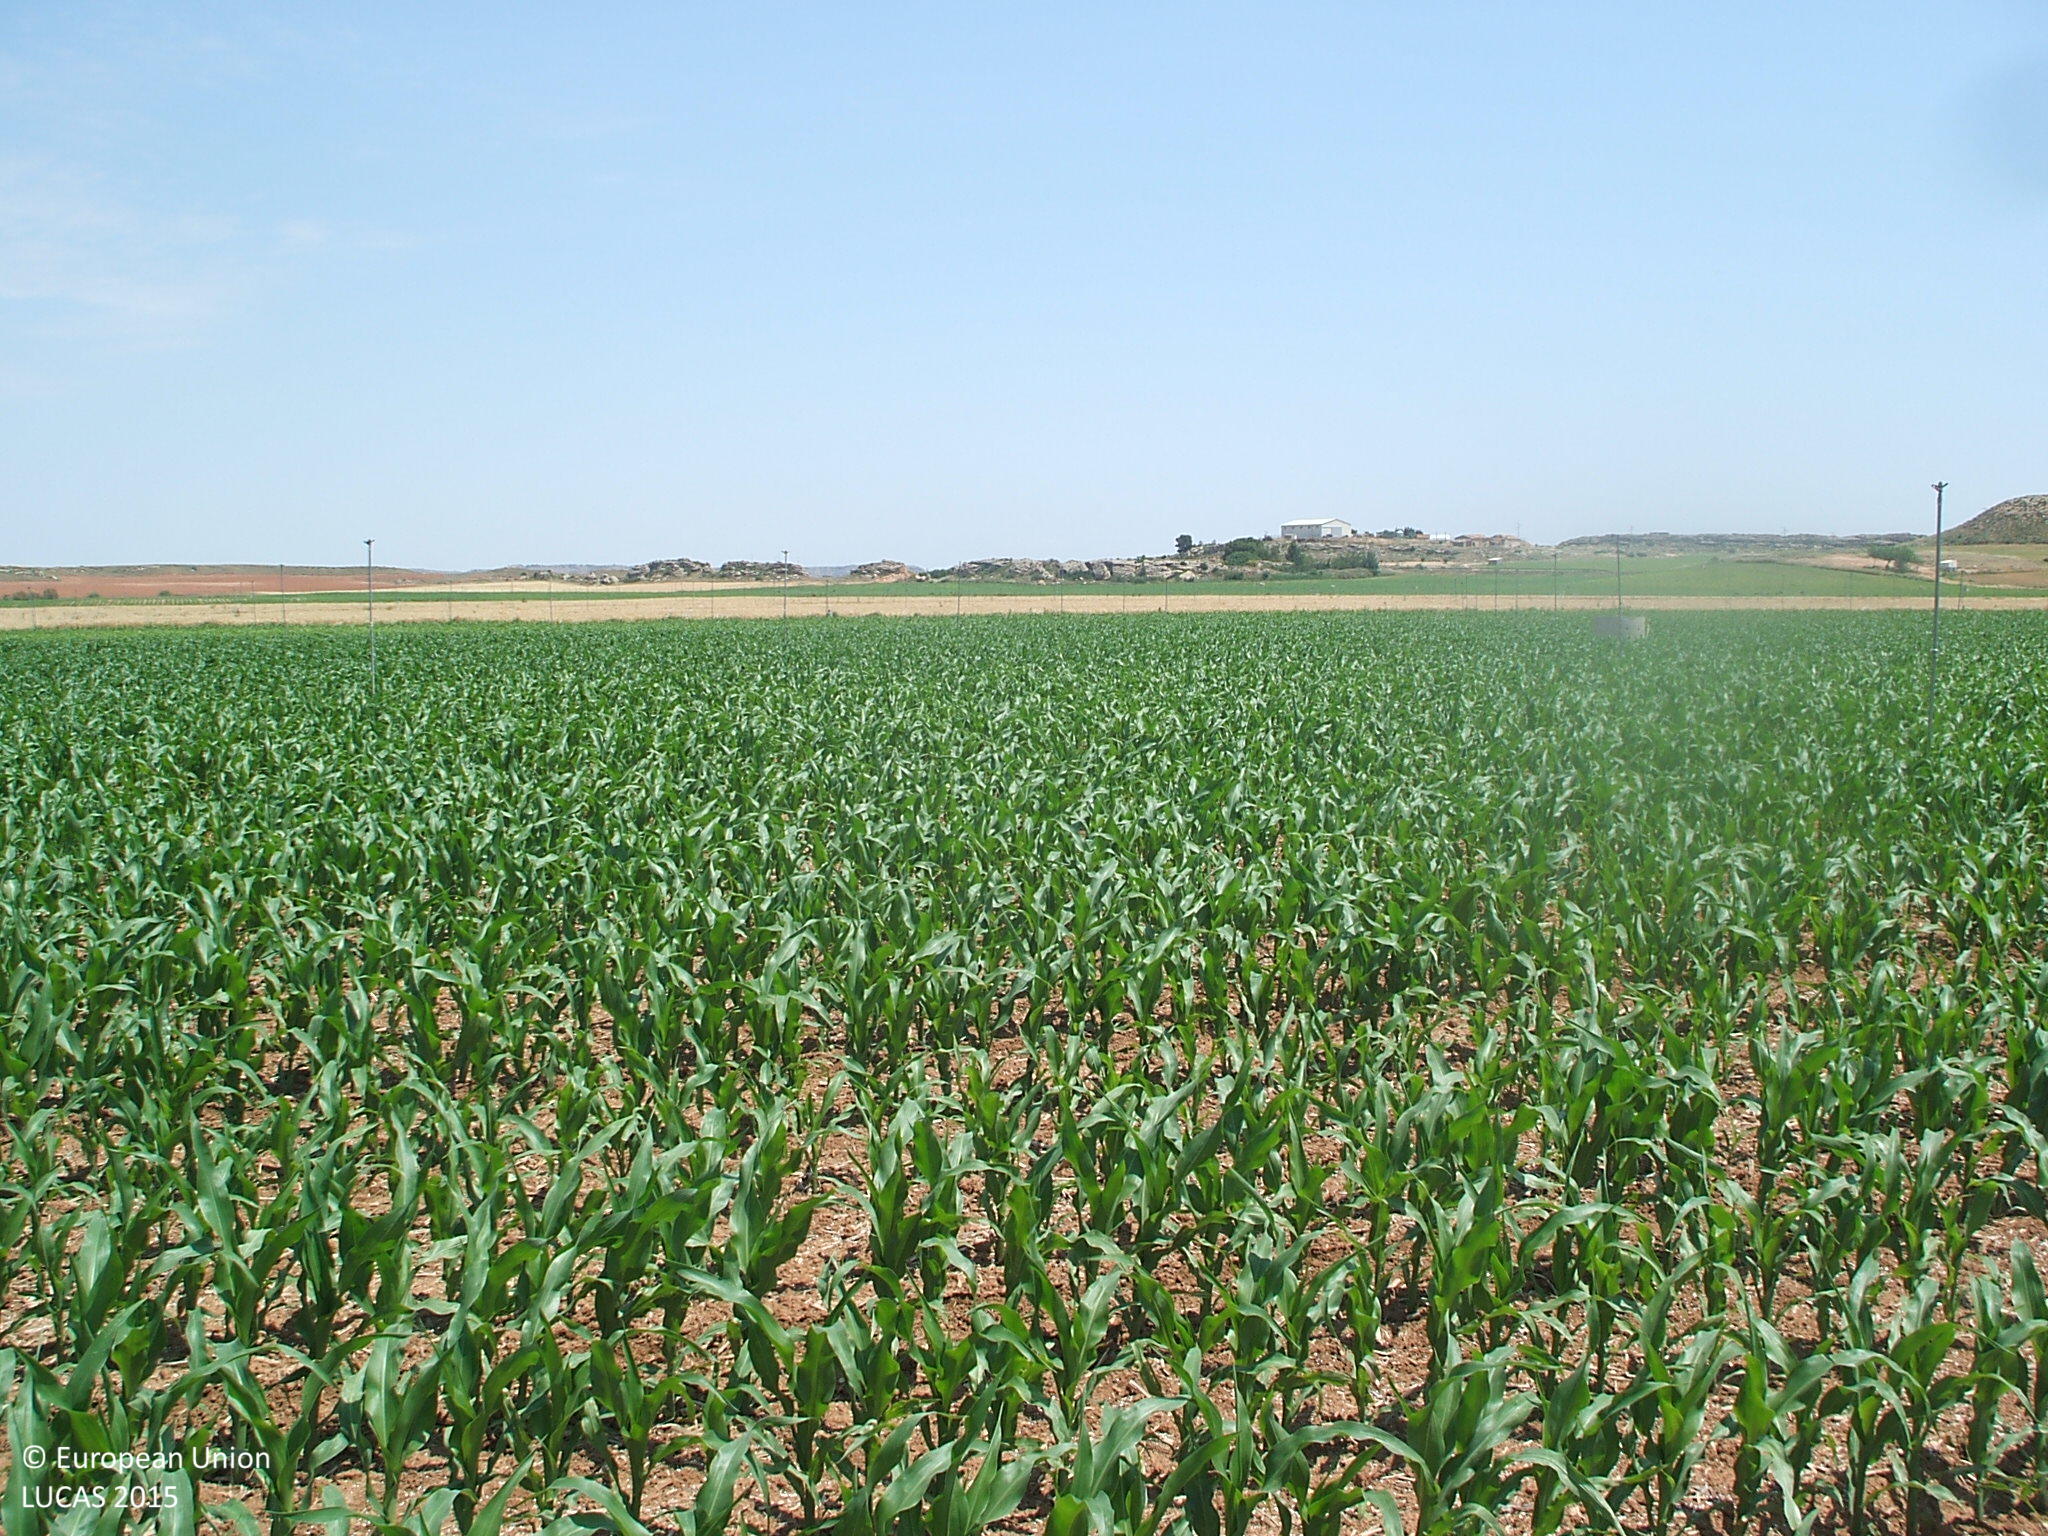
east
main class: Cropland
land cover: Maize
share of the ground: 50 - 75 %
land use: Agriculture (excluding fallow land and kitchen gardens)
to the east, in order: Maize; Grass margins; Barley
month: June
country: ES
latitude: 41.0273
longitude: -0.2042
